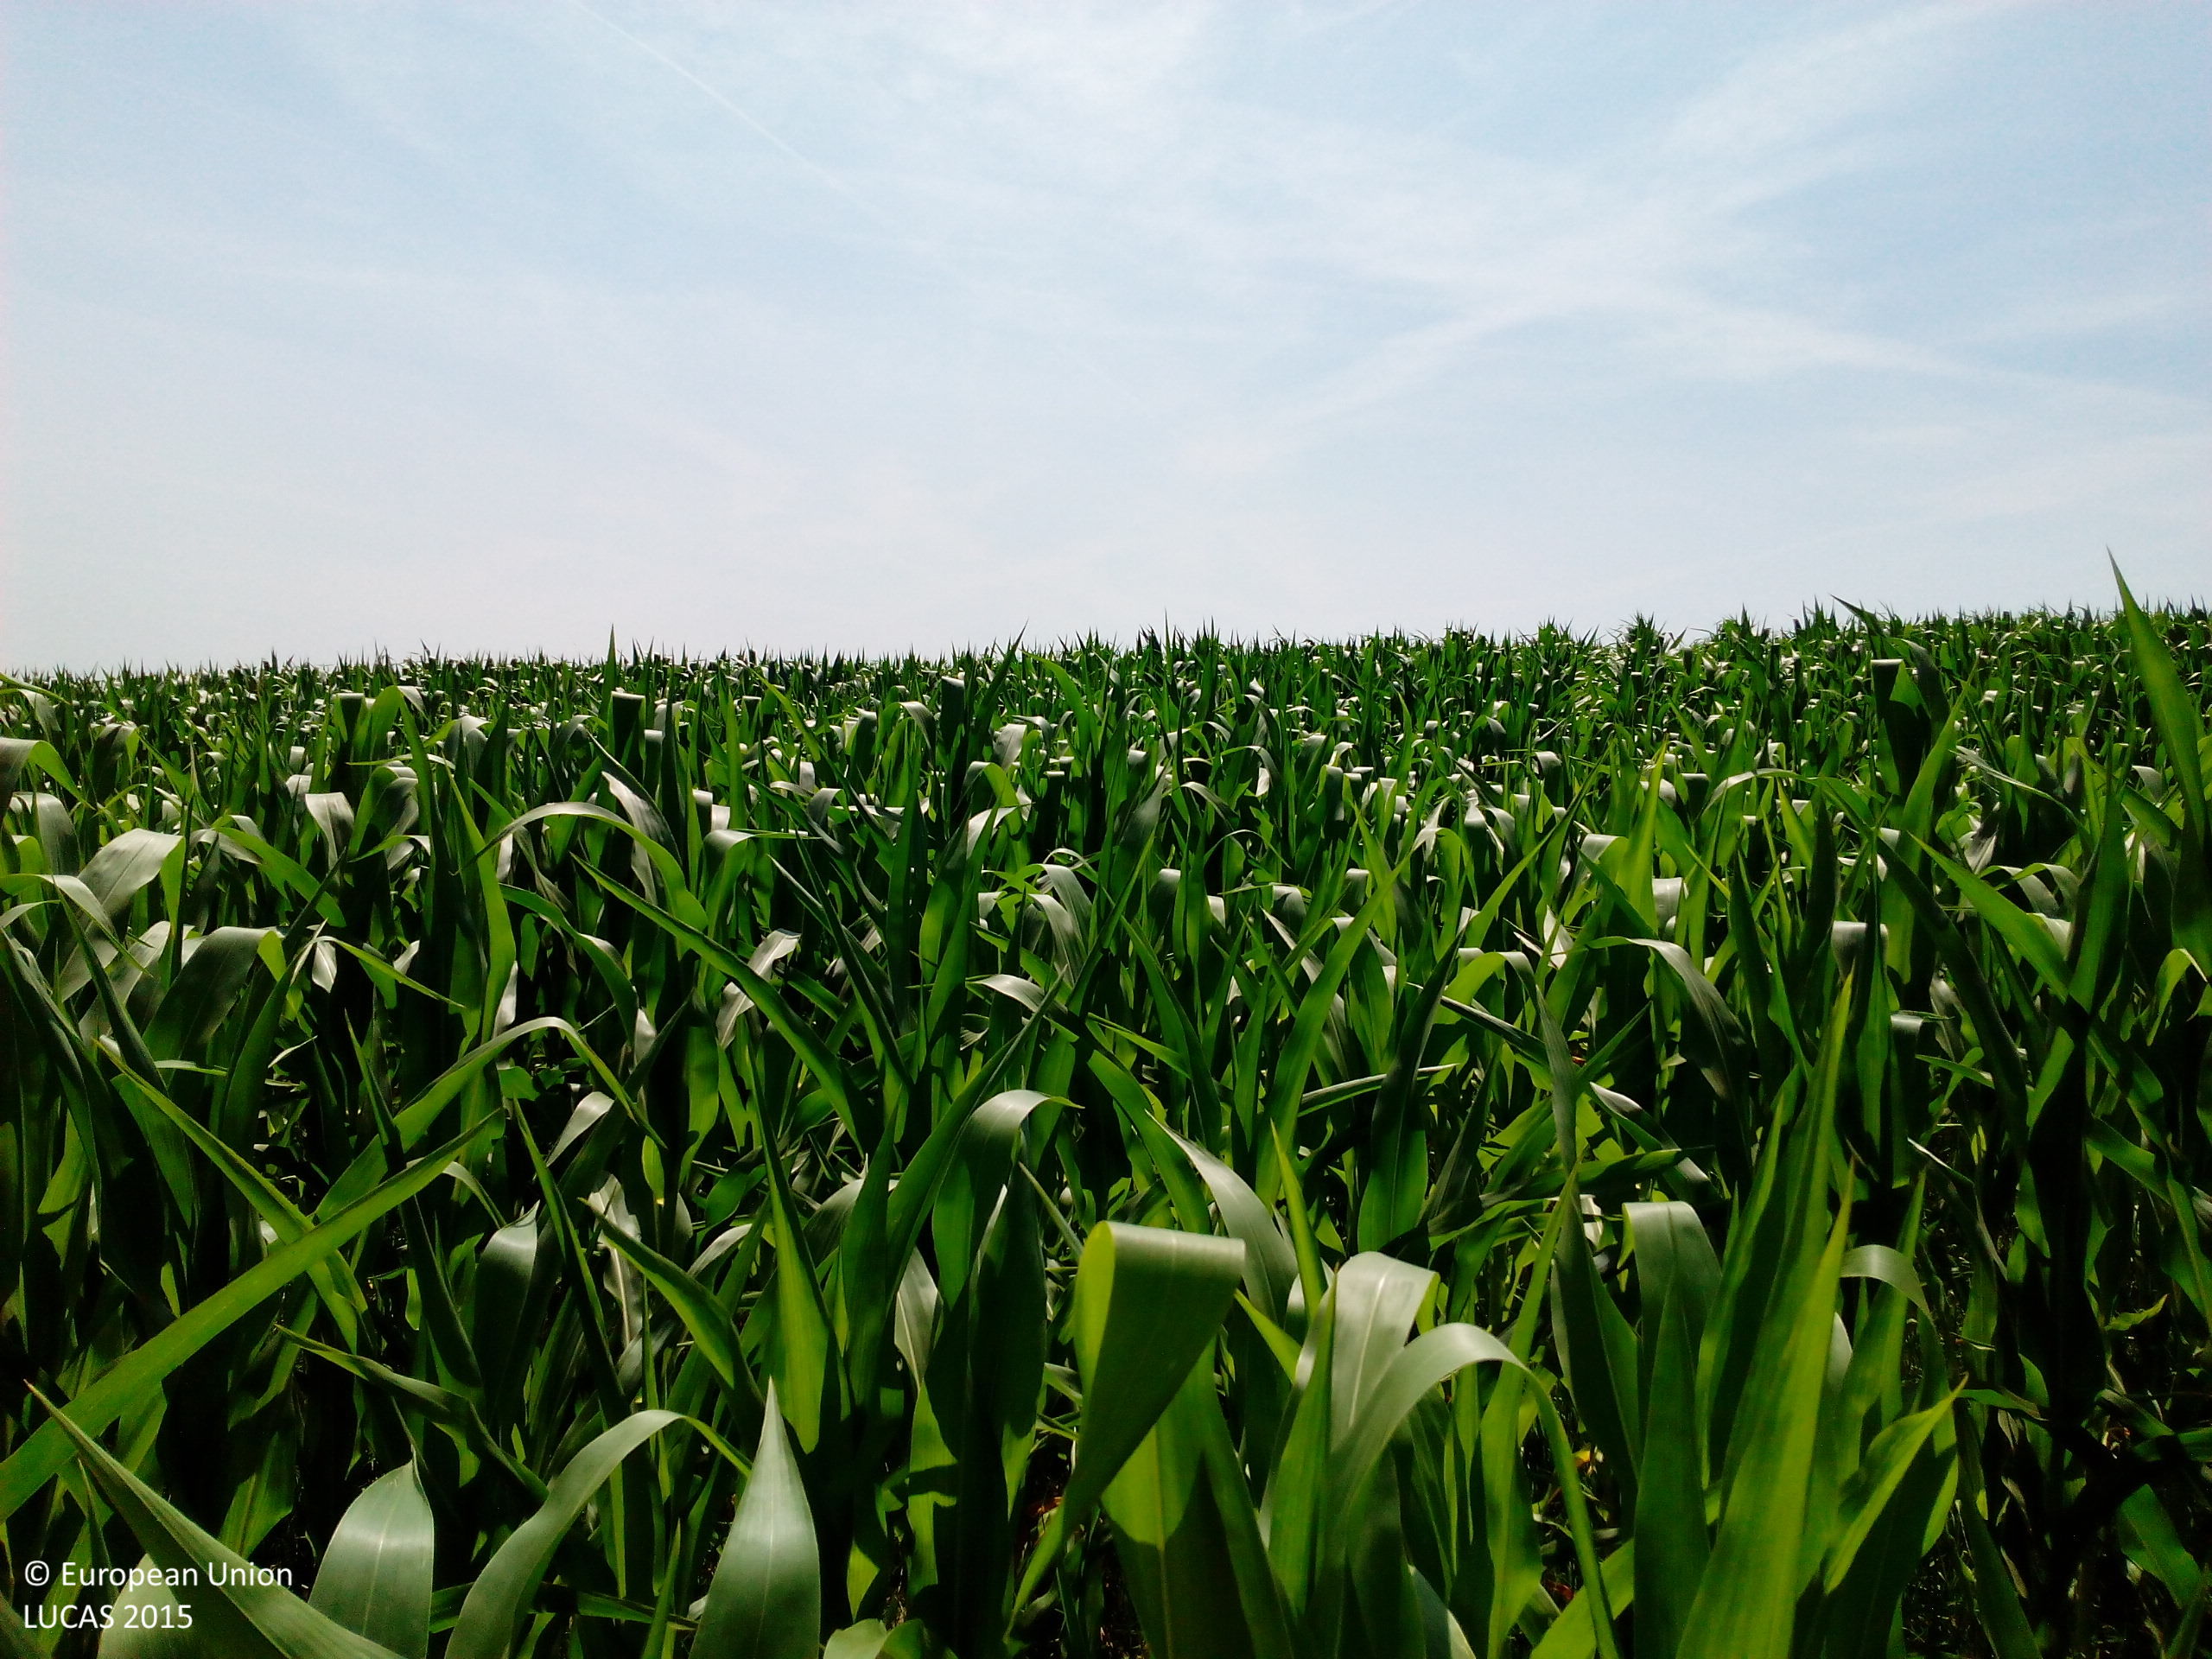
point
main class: Cropland
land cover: Maize
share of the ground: > 75 %
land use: Agriculture (excluding fallow land and kitchen gardens)
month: July
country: DE
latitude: 47.6751
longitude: 7.5907
